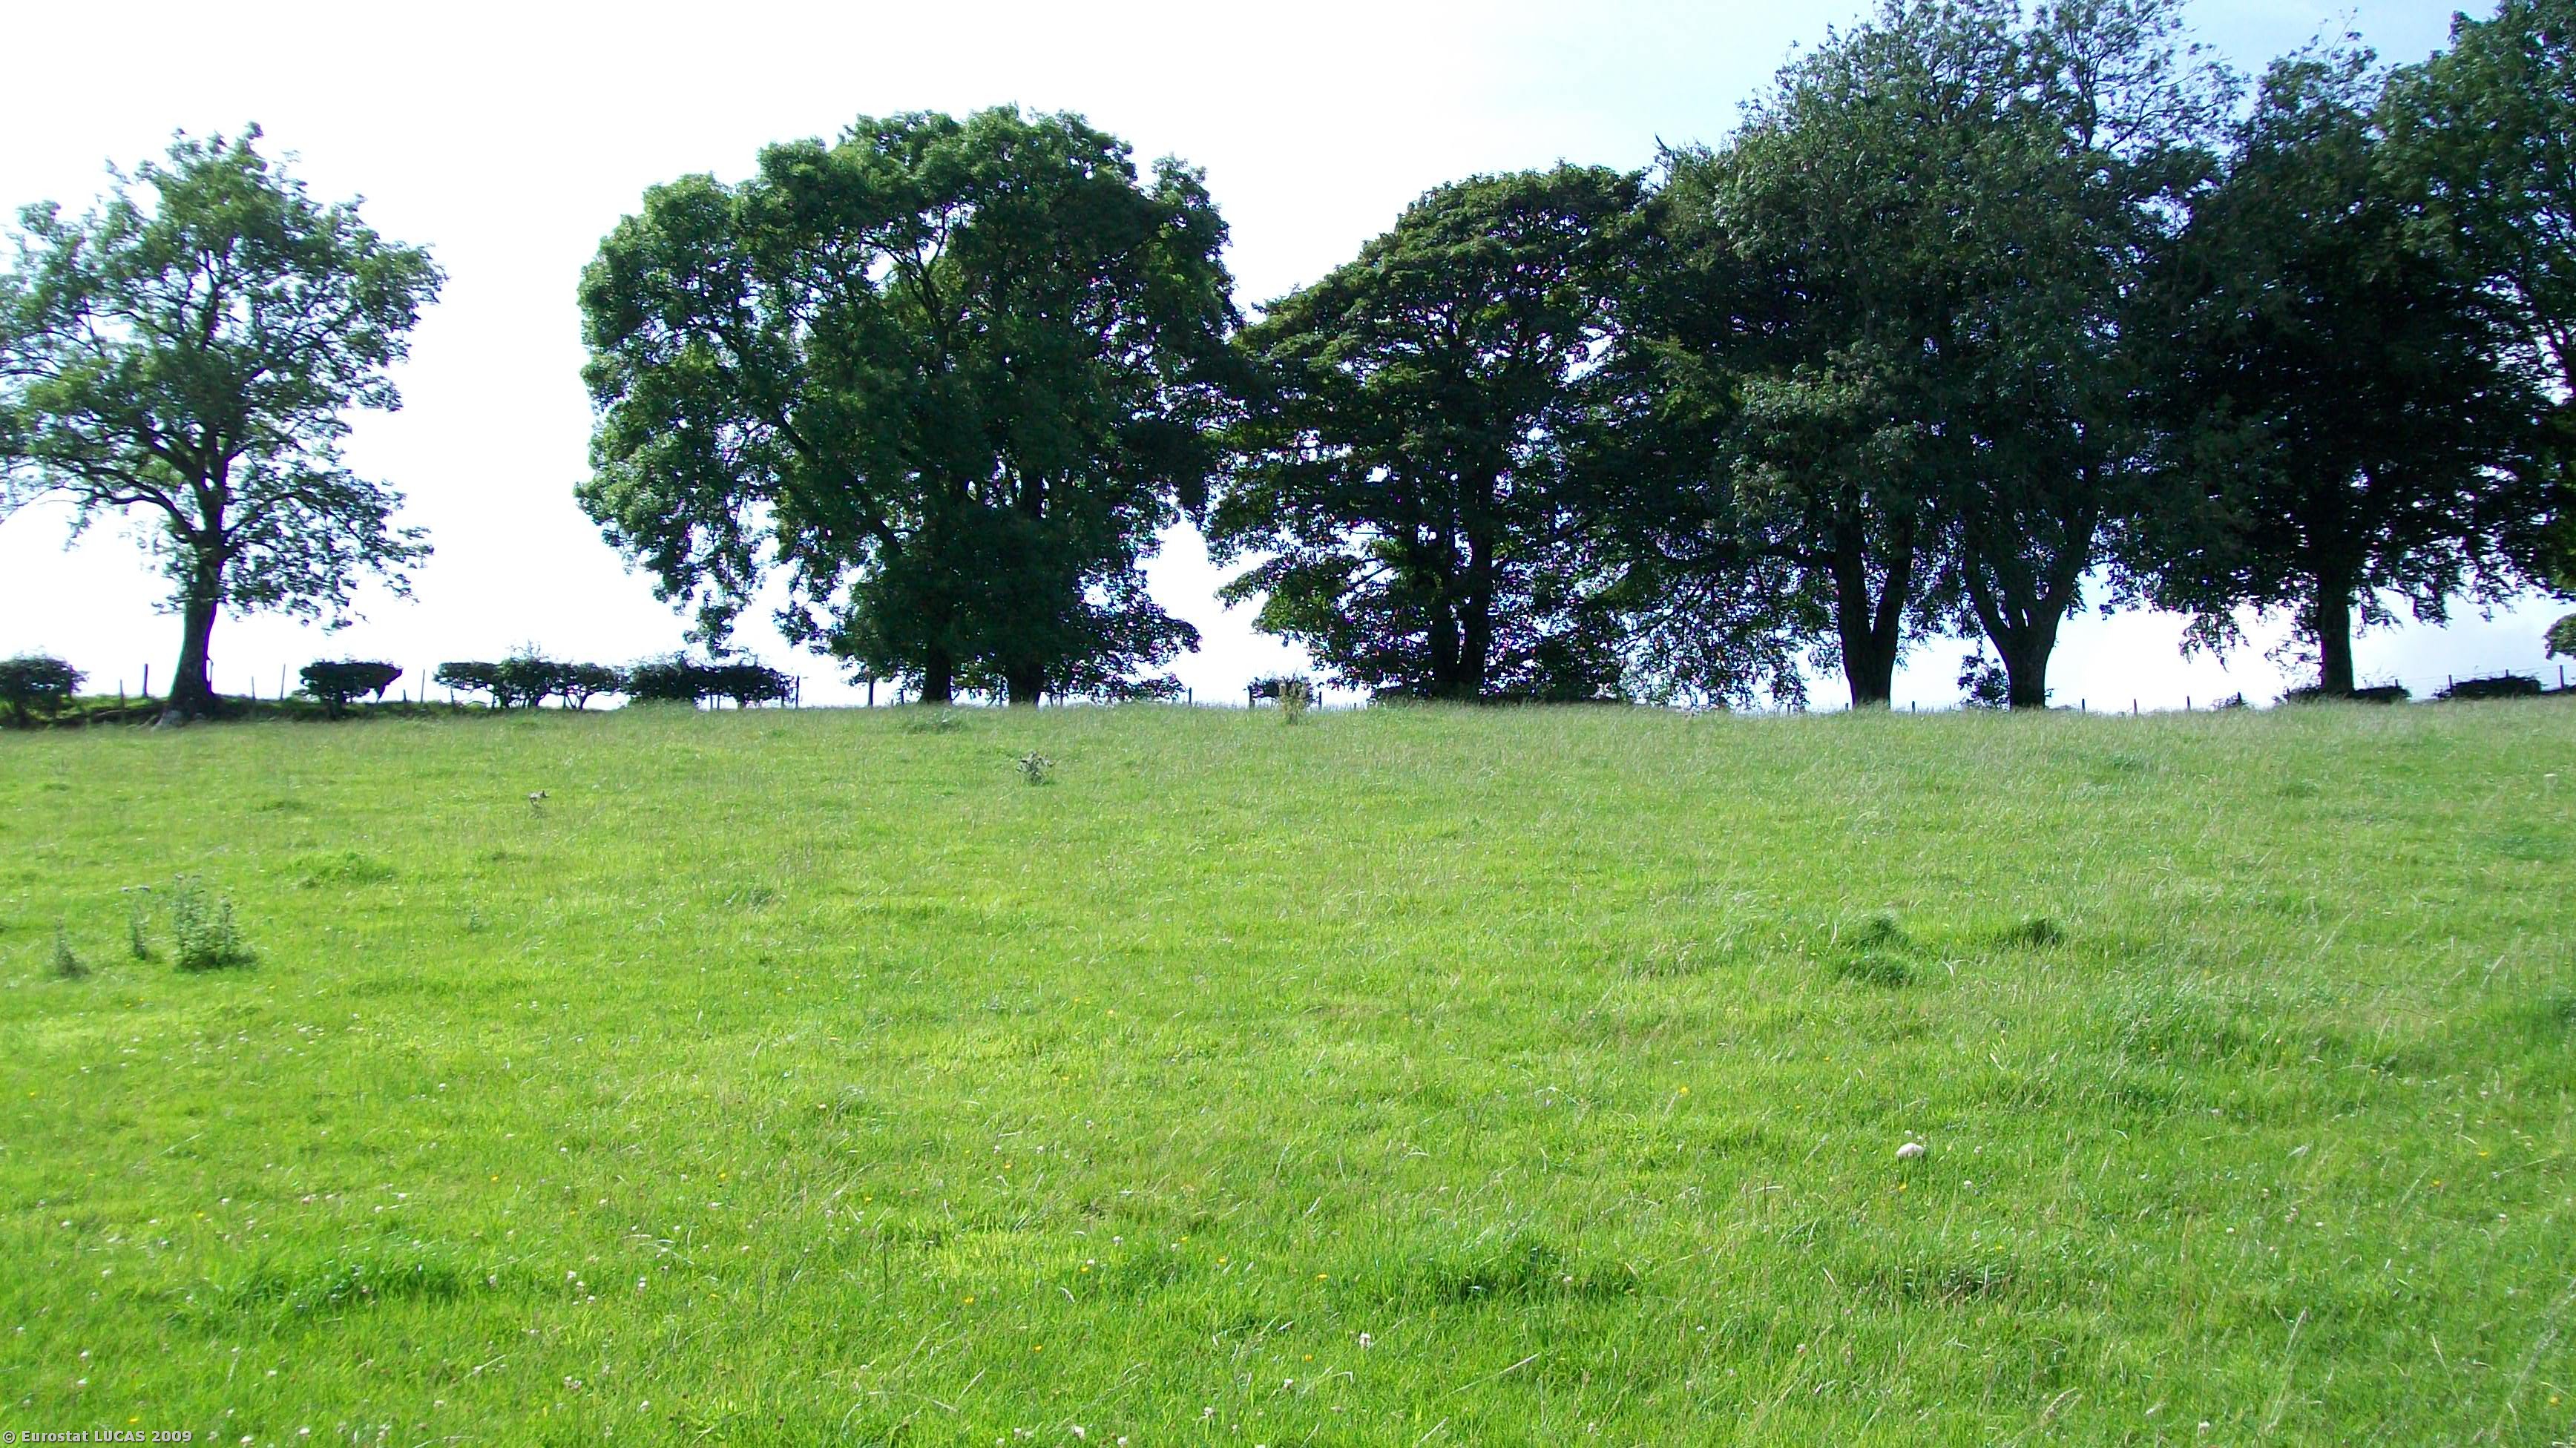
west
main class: Grassland
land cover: Grassland without tree/shrub cover
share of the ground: > 75 %
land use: Agriculture (excluding fallow land and kitchen gardens)
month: August
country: GB
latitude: 55.1939
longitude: -3.3512
